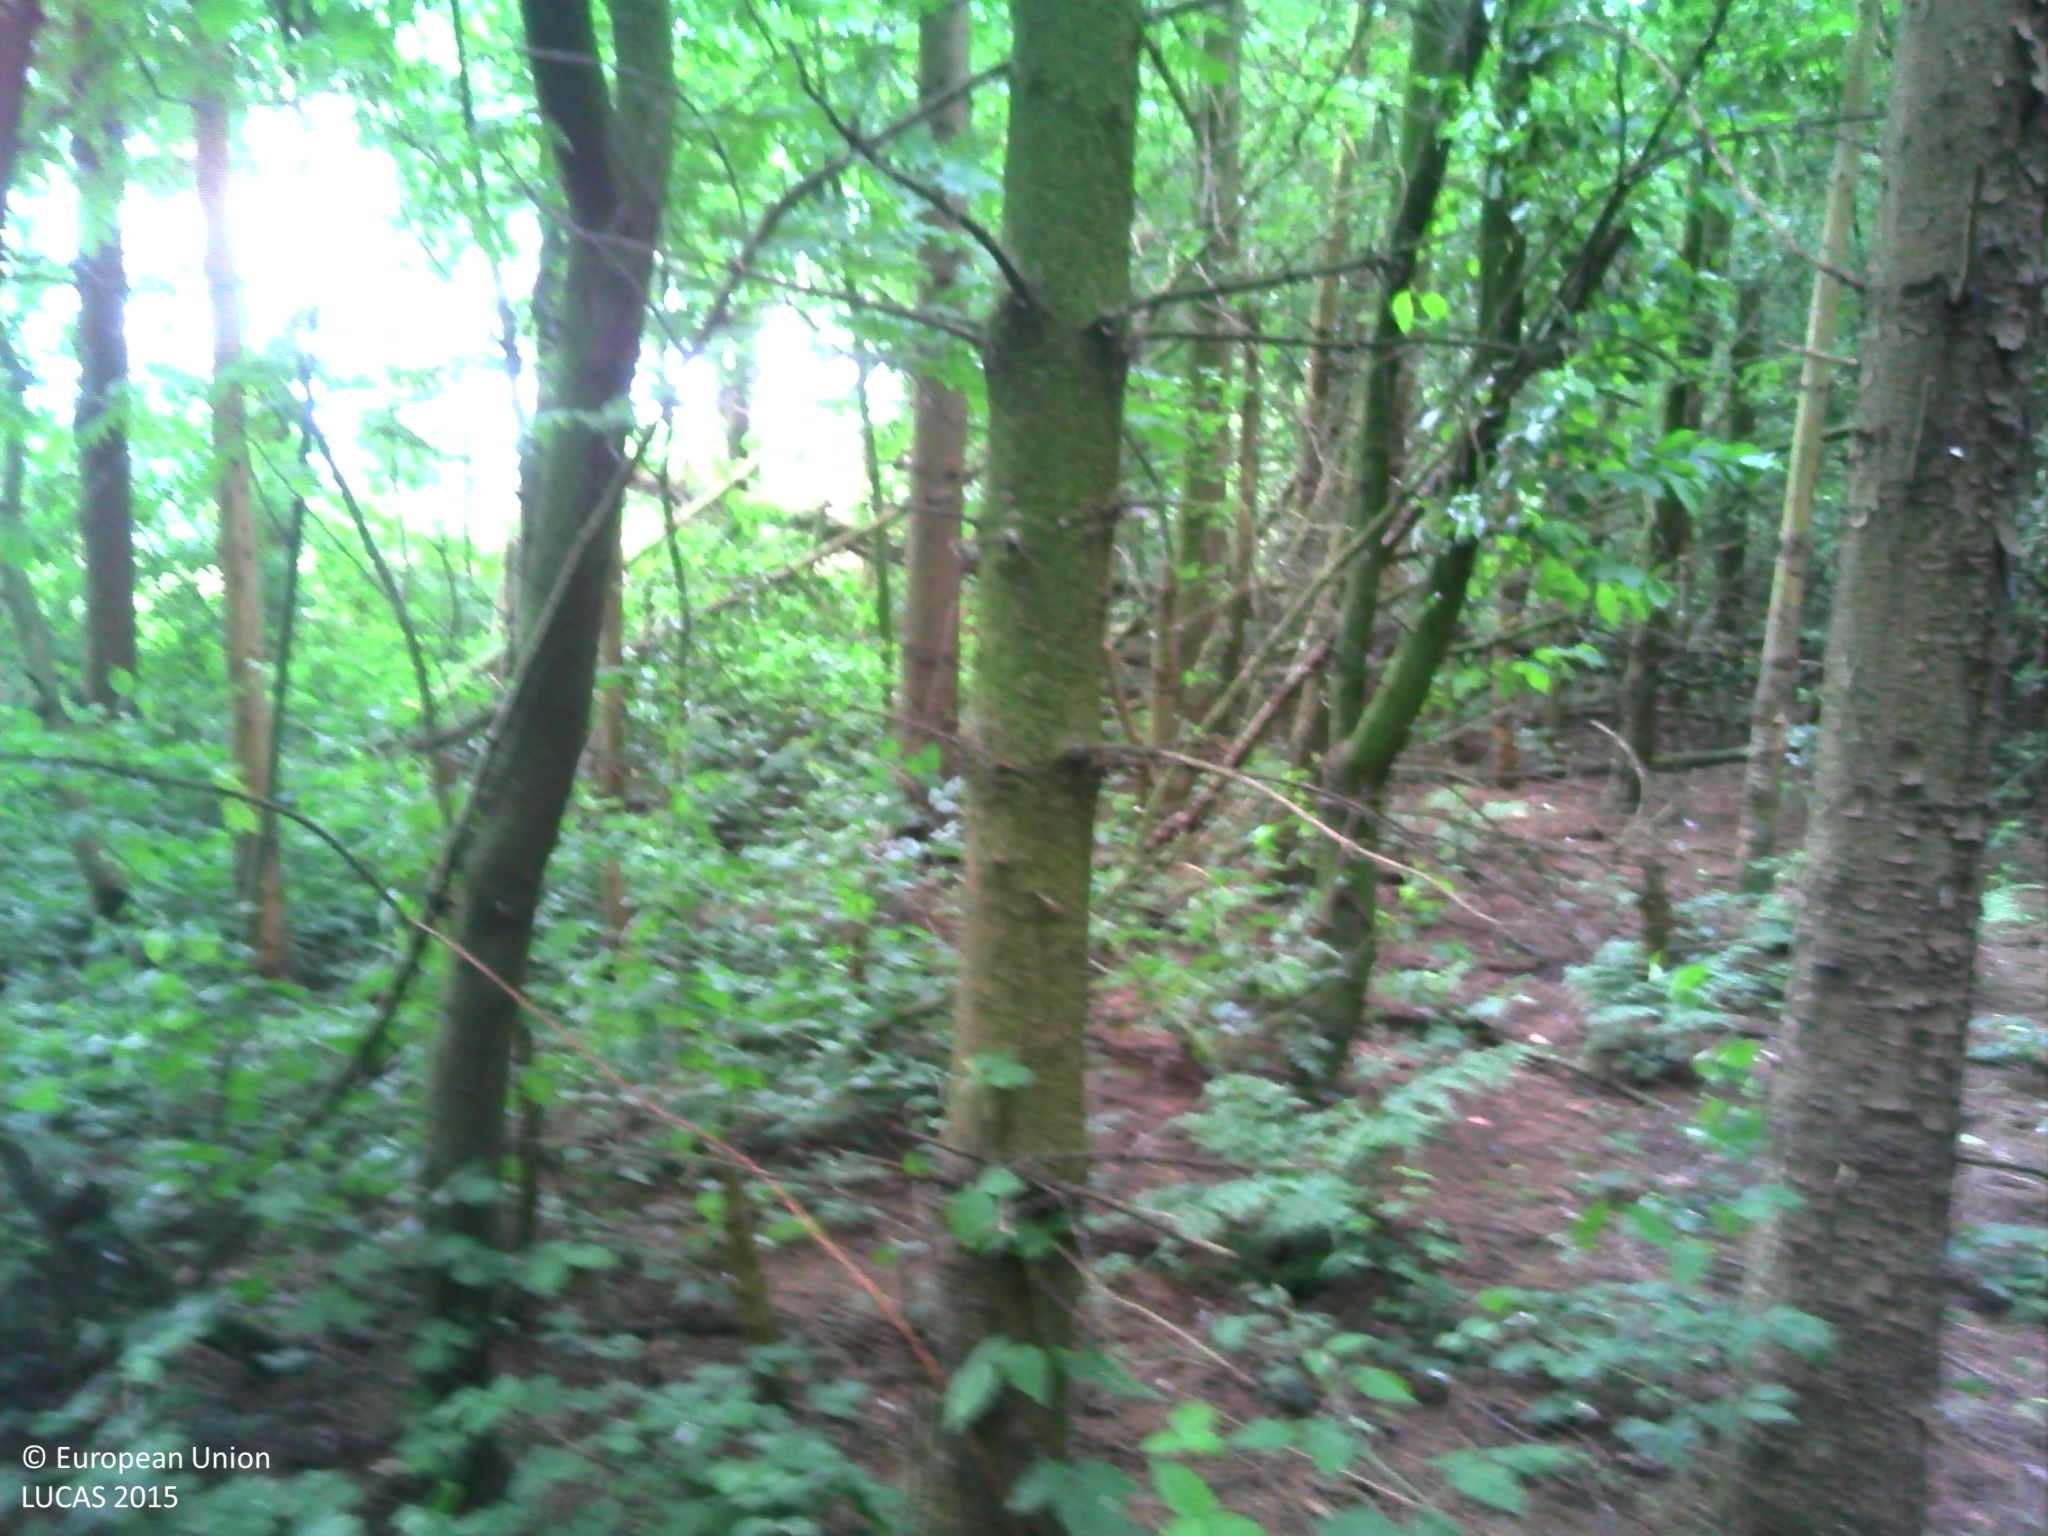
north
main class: Woodland
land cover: Spruce dominated coniferous woodland
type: exotic forest
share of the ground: > 75 %
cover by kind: coniferous forest trees 100 %
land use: Forestry
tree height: > 5 m
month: June
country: BE
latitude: 51.0515
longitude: 3.6160
